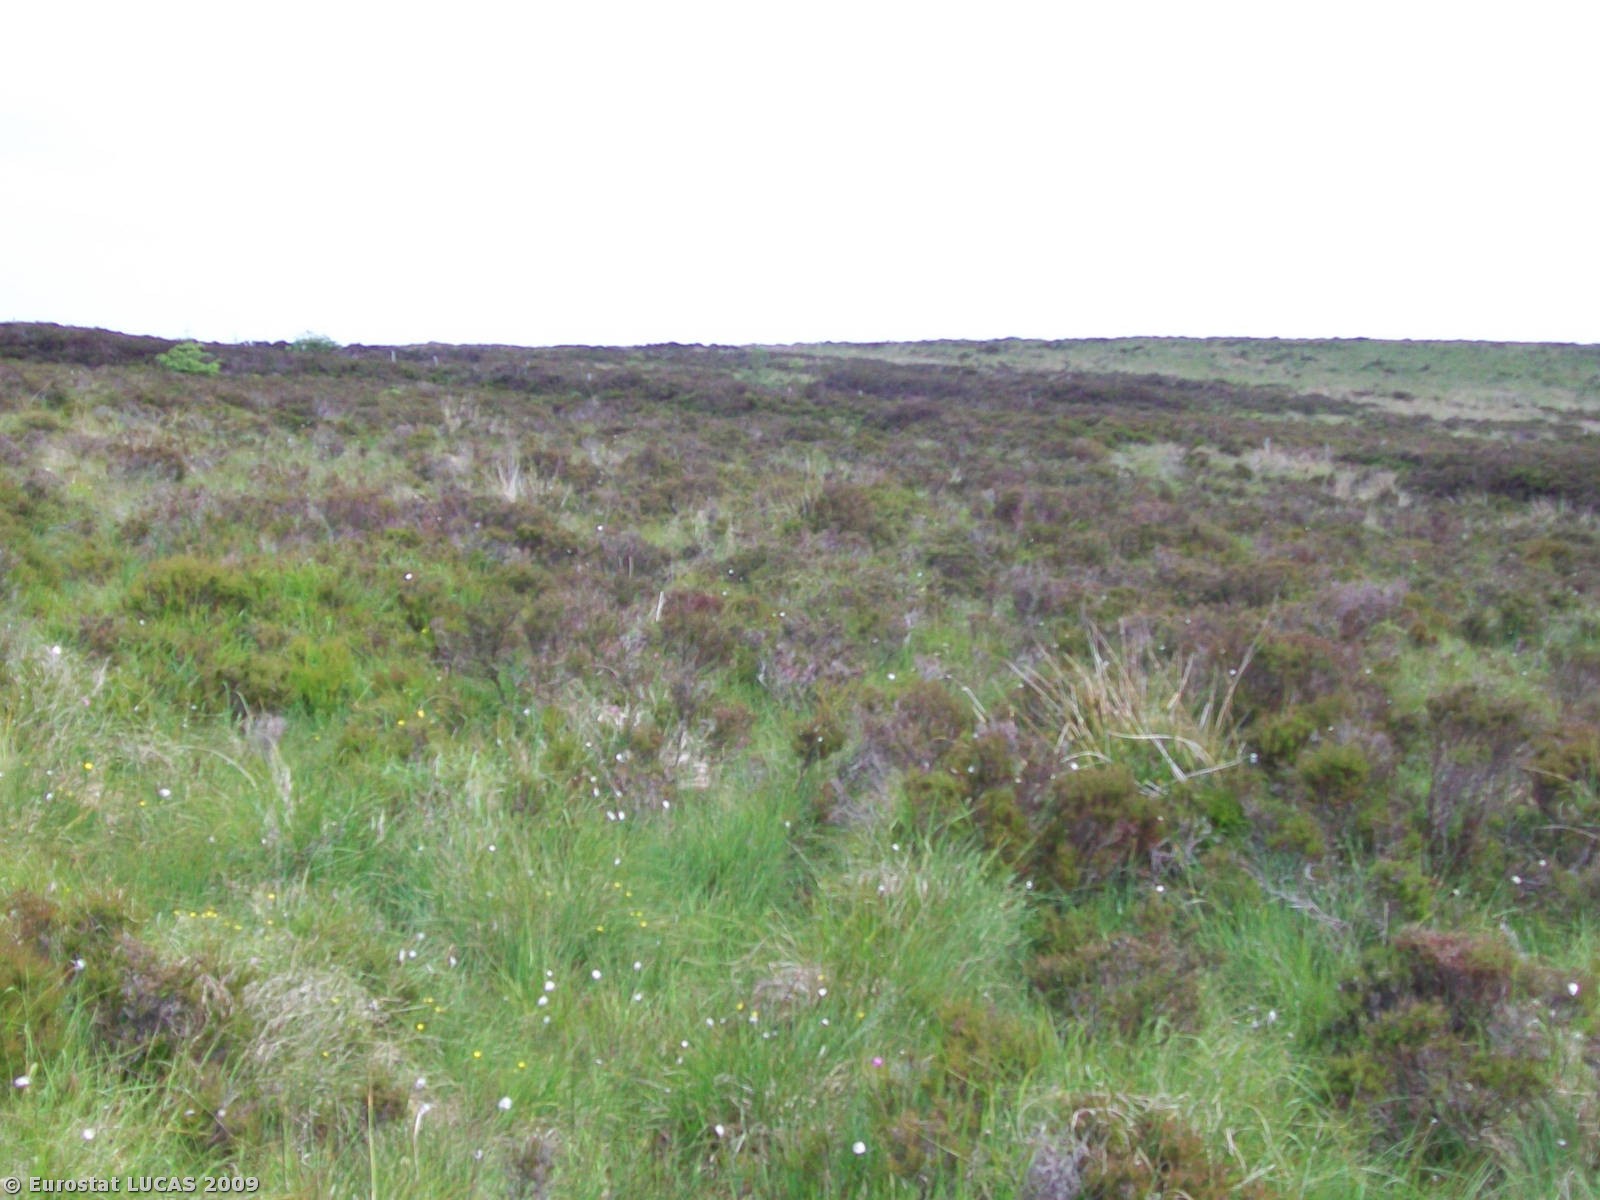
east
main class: Shrubland
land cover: Shrubland without tree cover
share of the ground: > 75 %
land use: Agriculture (excluding fallow land and kitchen gardens)
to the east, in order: Shrubland without tree cover; Fences; Shrubland without tree cover; Fences; Shrubland without tree cover
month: June
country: GB
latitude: 54.2874
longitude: -7.2456
